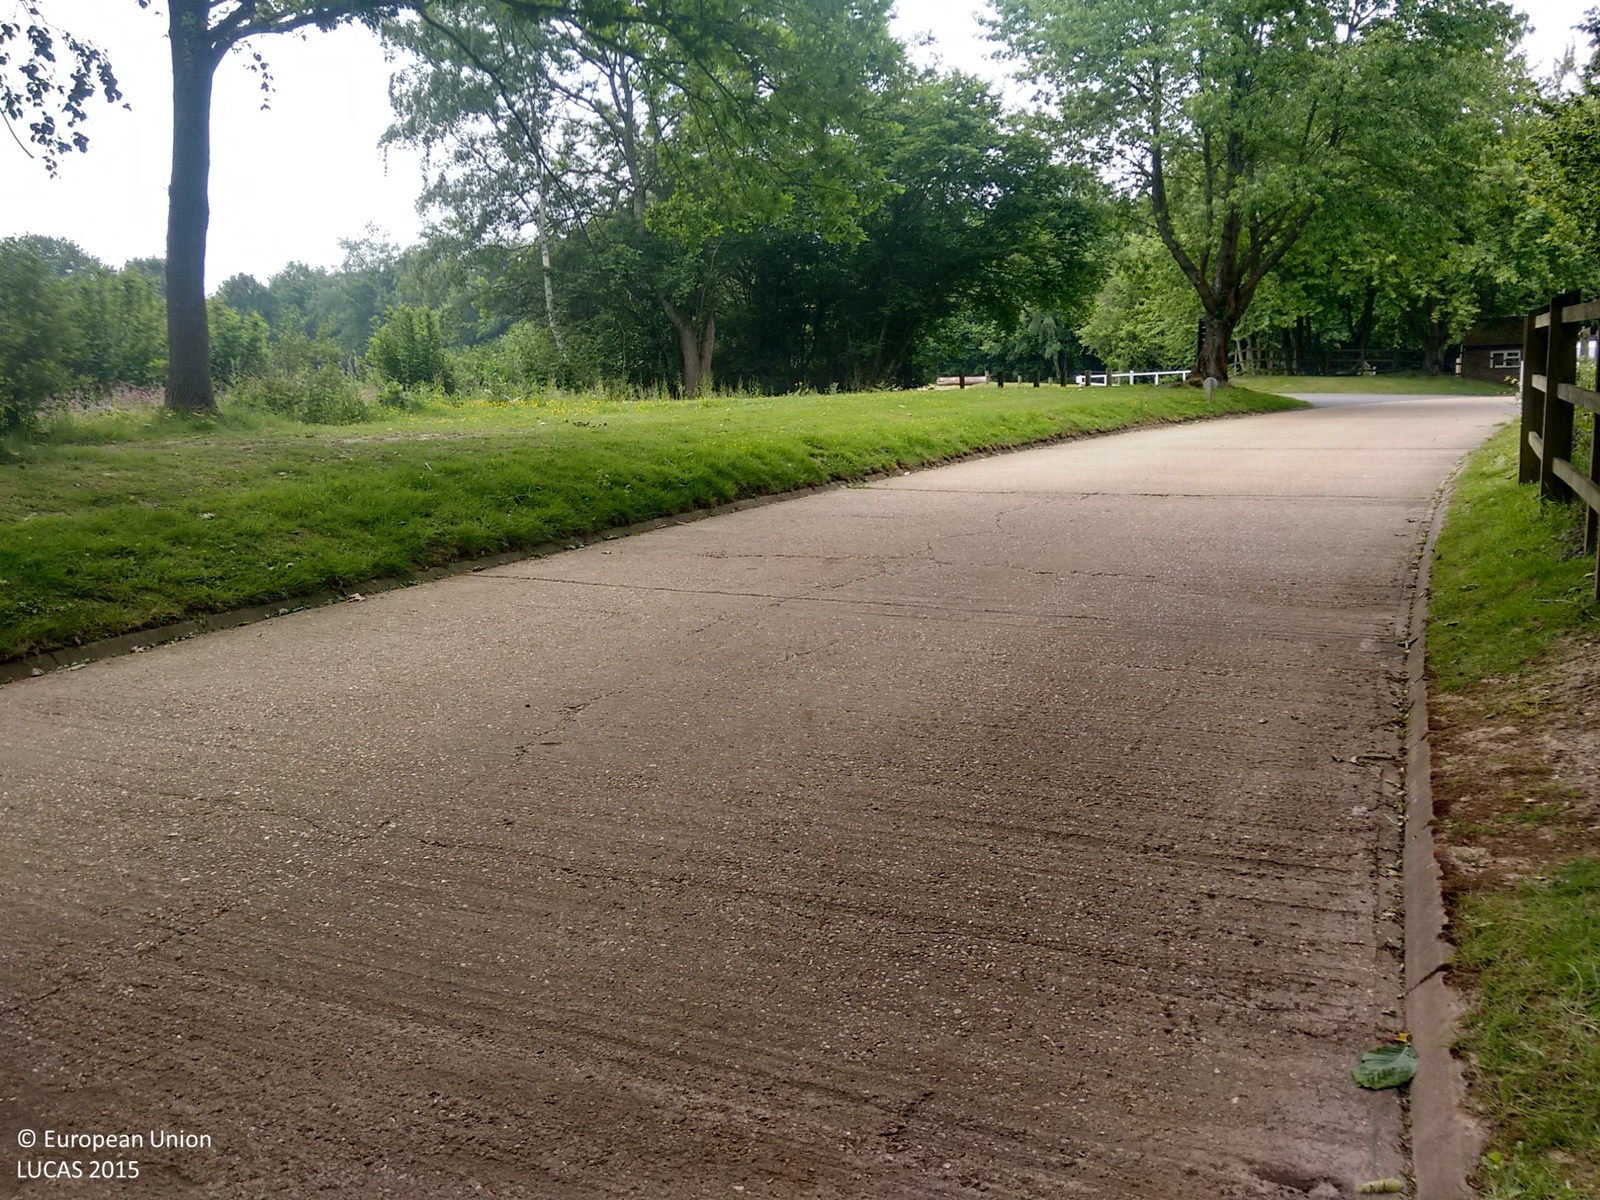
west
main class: Woodland
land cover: Broadleaved woodland
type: mesophytic deciduous forest
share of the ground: > 75 %
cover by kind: broadleaved forest trees 90 %, shrubs 10 %
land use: Waste treatment
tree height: > 5 m
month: June
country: GB
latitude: 51.0816
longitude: 0.3927
